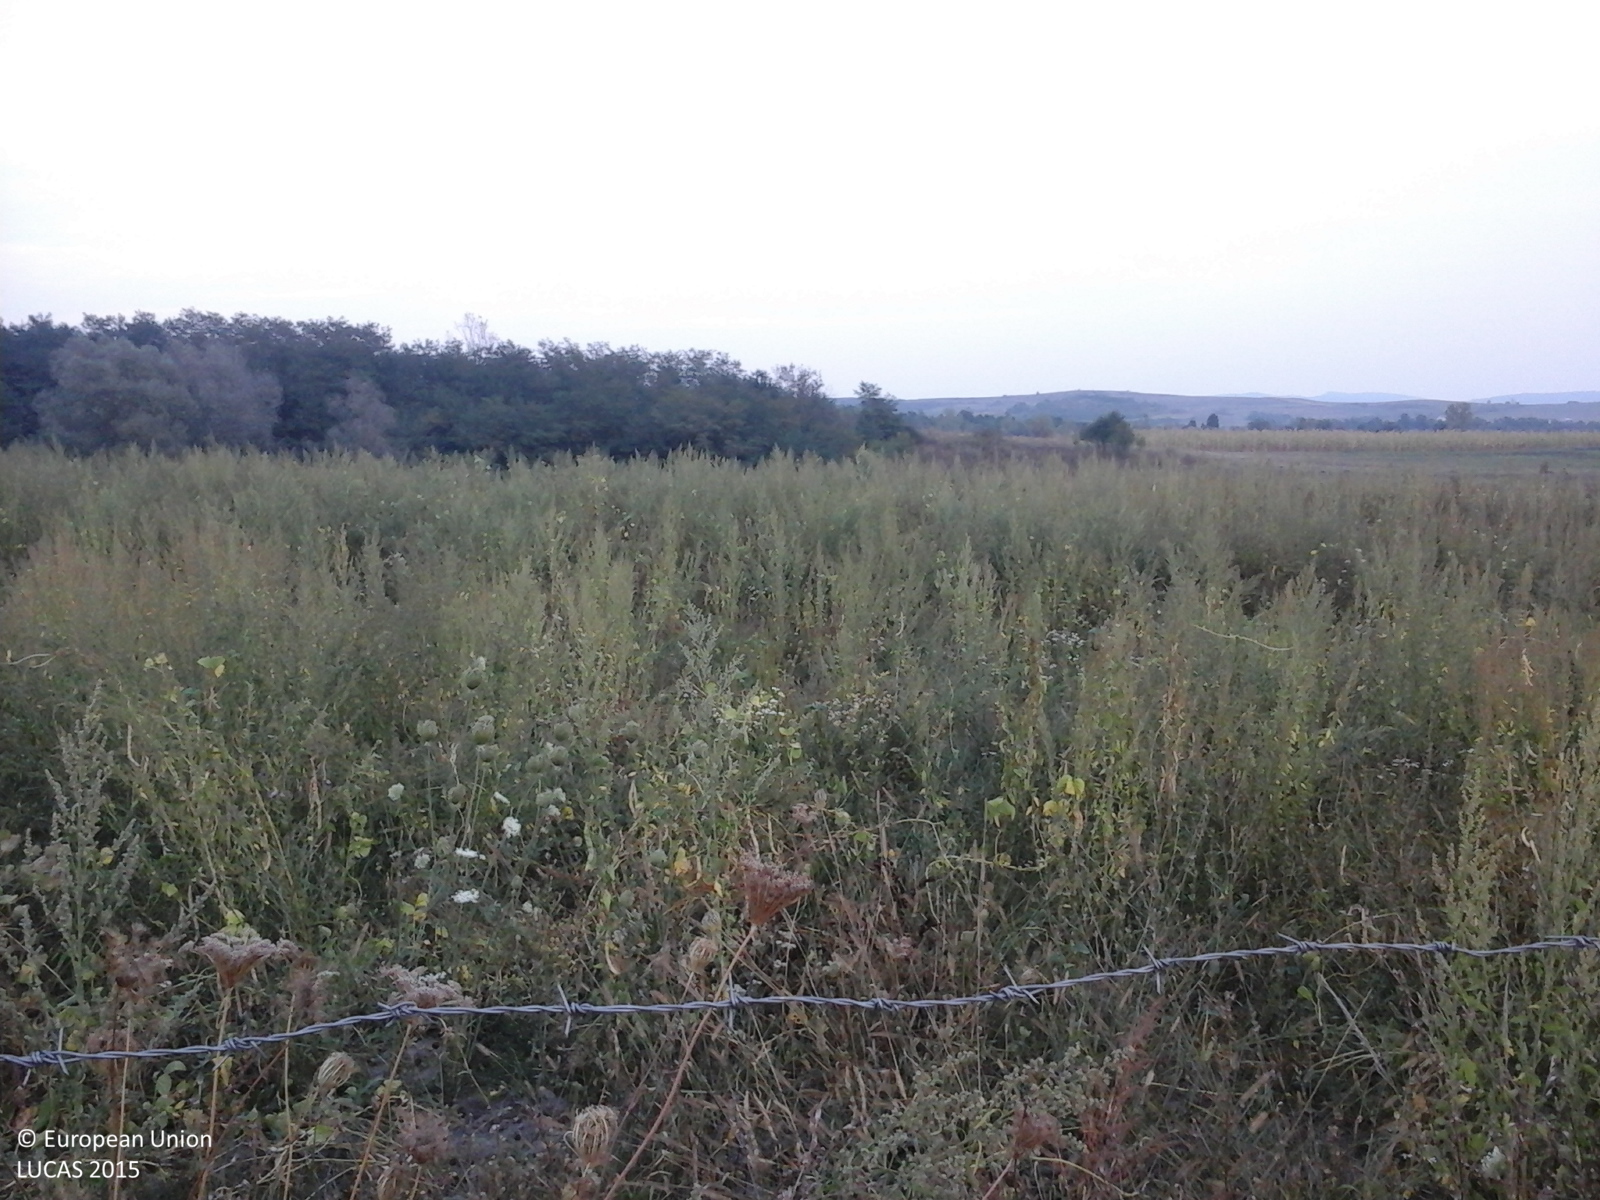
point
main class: Grassland
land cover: Spontaneously vegetated surfaces
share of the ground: > 75 %
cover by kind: herbaceous plants 100 %
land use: Agriculture (excluding fallow land and kitchen gardens)
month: September
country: RO
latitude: 47.2429
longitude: 24.3432
